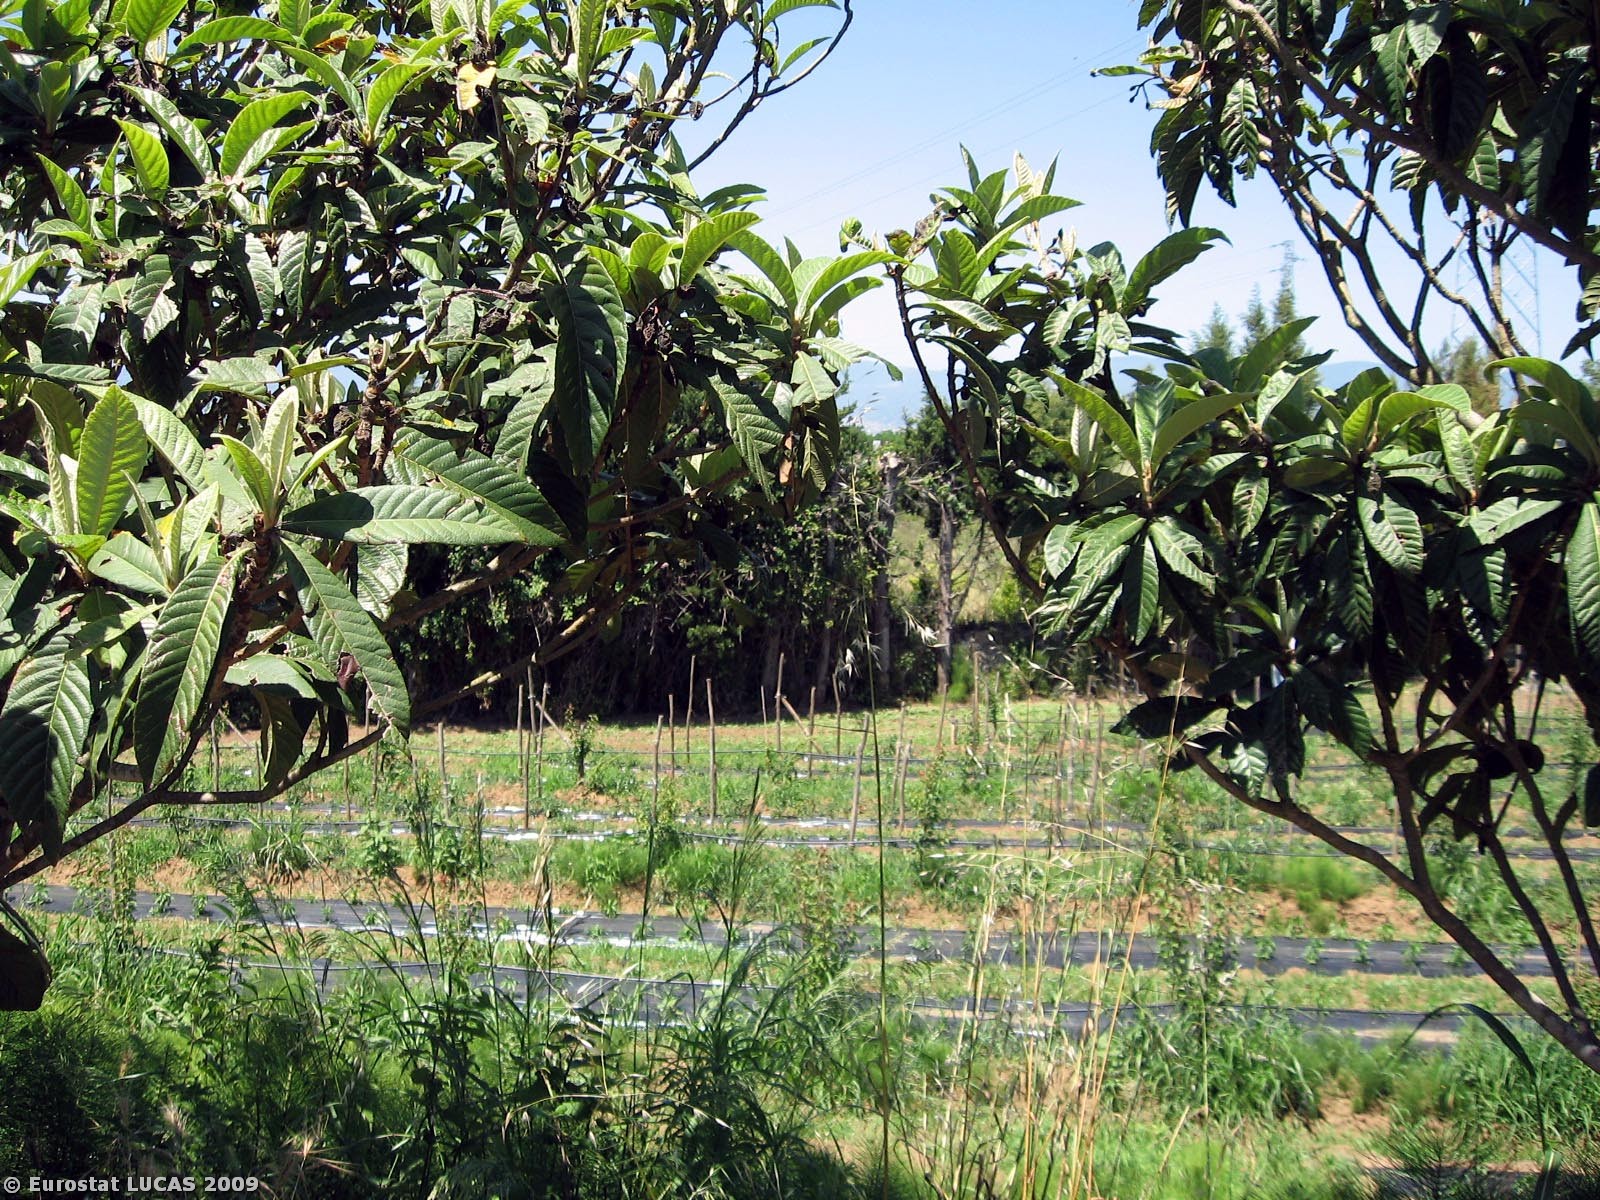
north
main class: Shrubland
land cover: Shrubland with sparse tree cover
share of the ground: > 75 %
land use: Unused
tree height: > 5 m
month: June
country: IT
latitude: 38.8499
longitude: 16.2693
